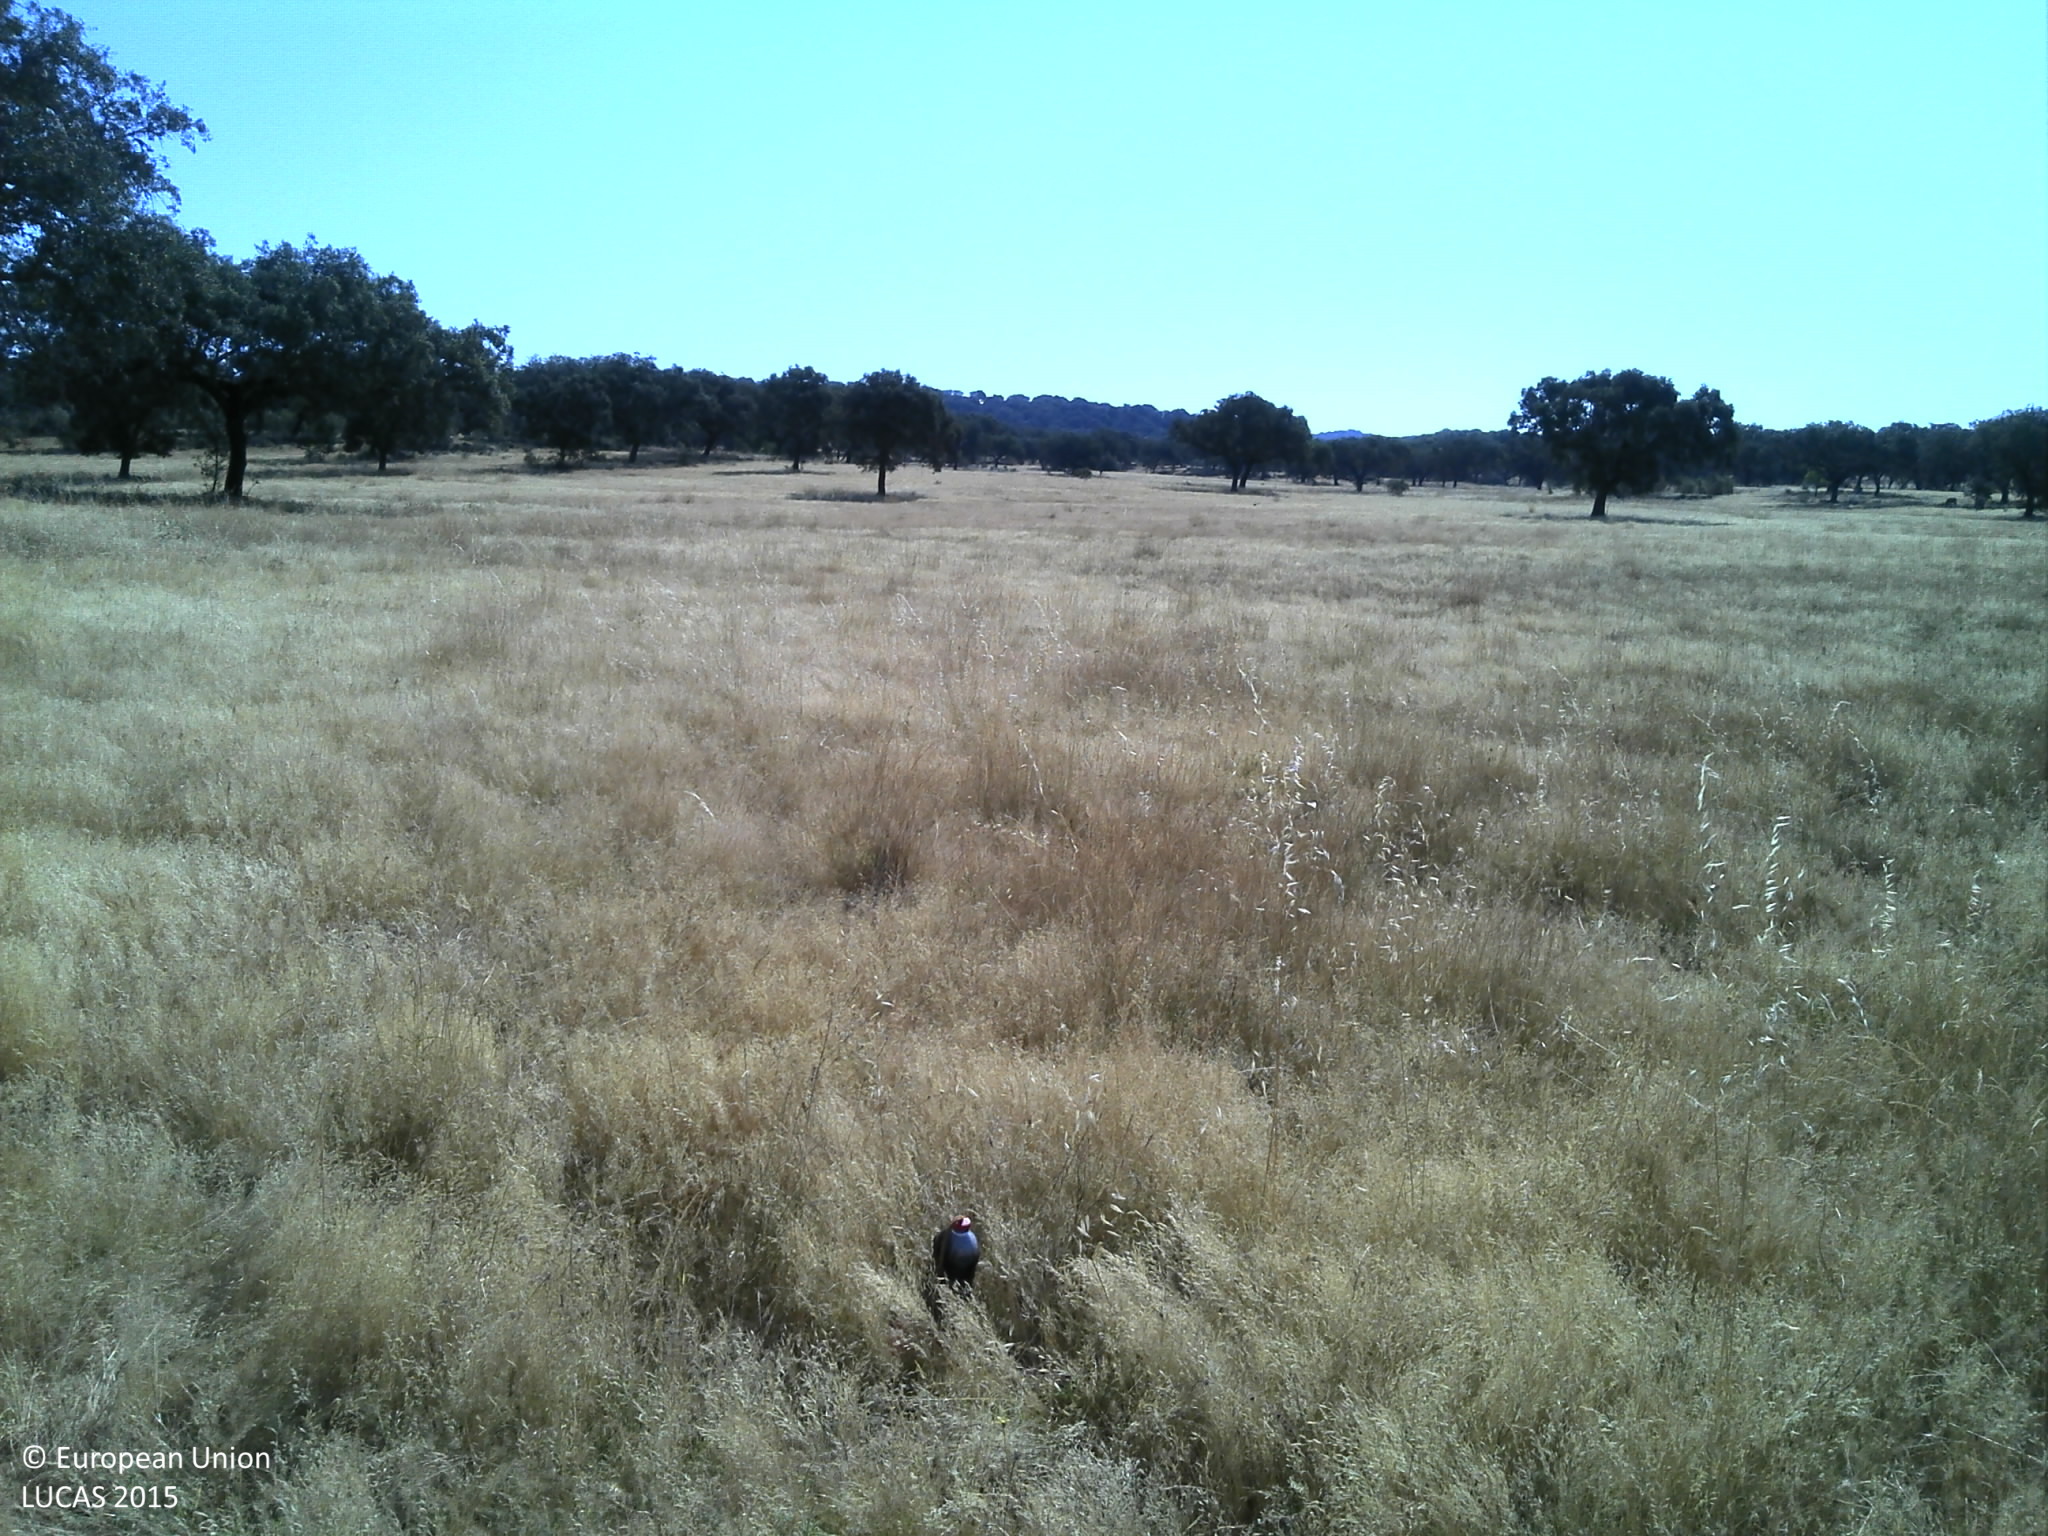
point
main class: Woodland
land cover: Broadleaved woodland
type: broadleaved evergreen forest
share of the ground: 10 - 25 %
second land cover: Grassland without tree/shrub cover
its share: 50 - 75 %
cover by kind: herbaceous plants 75 %, unconsolidated bare surface 15 %, broadleaved forest trees 10 %
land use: Forestry
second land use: Agriculture (excluding fallow land and kitchen gardens)
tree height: > 5 m
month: June
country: PT
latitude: 38.3161
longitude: -7.7706
